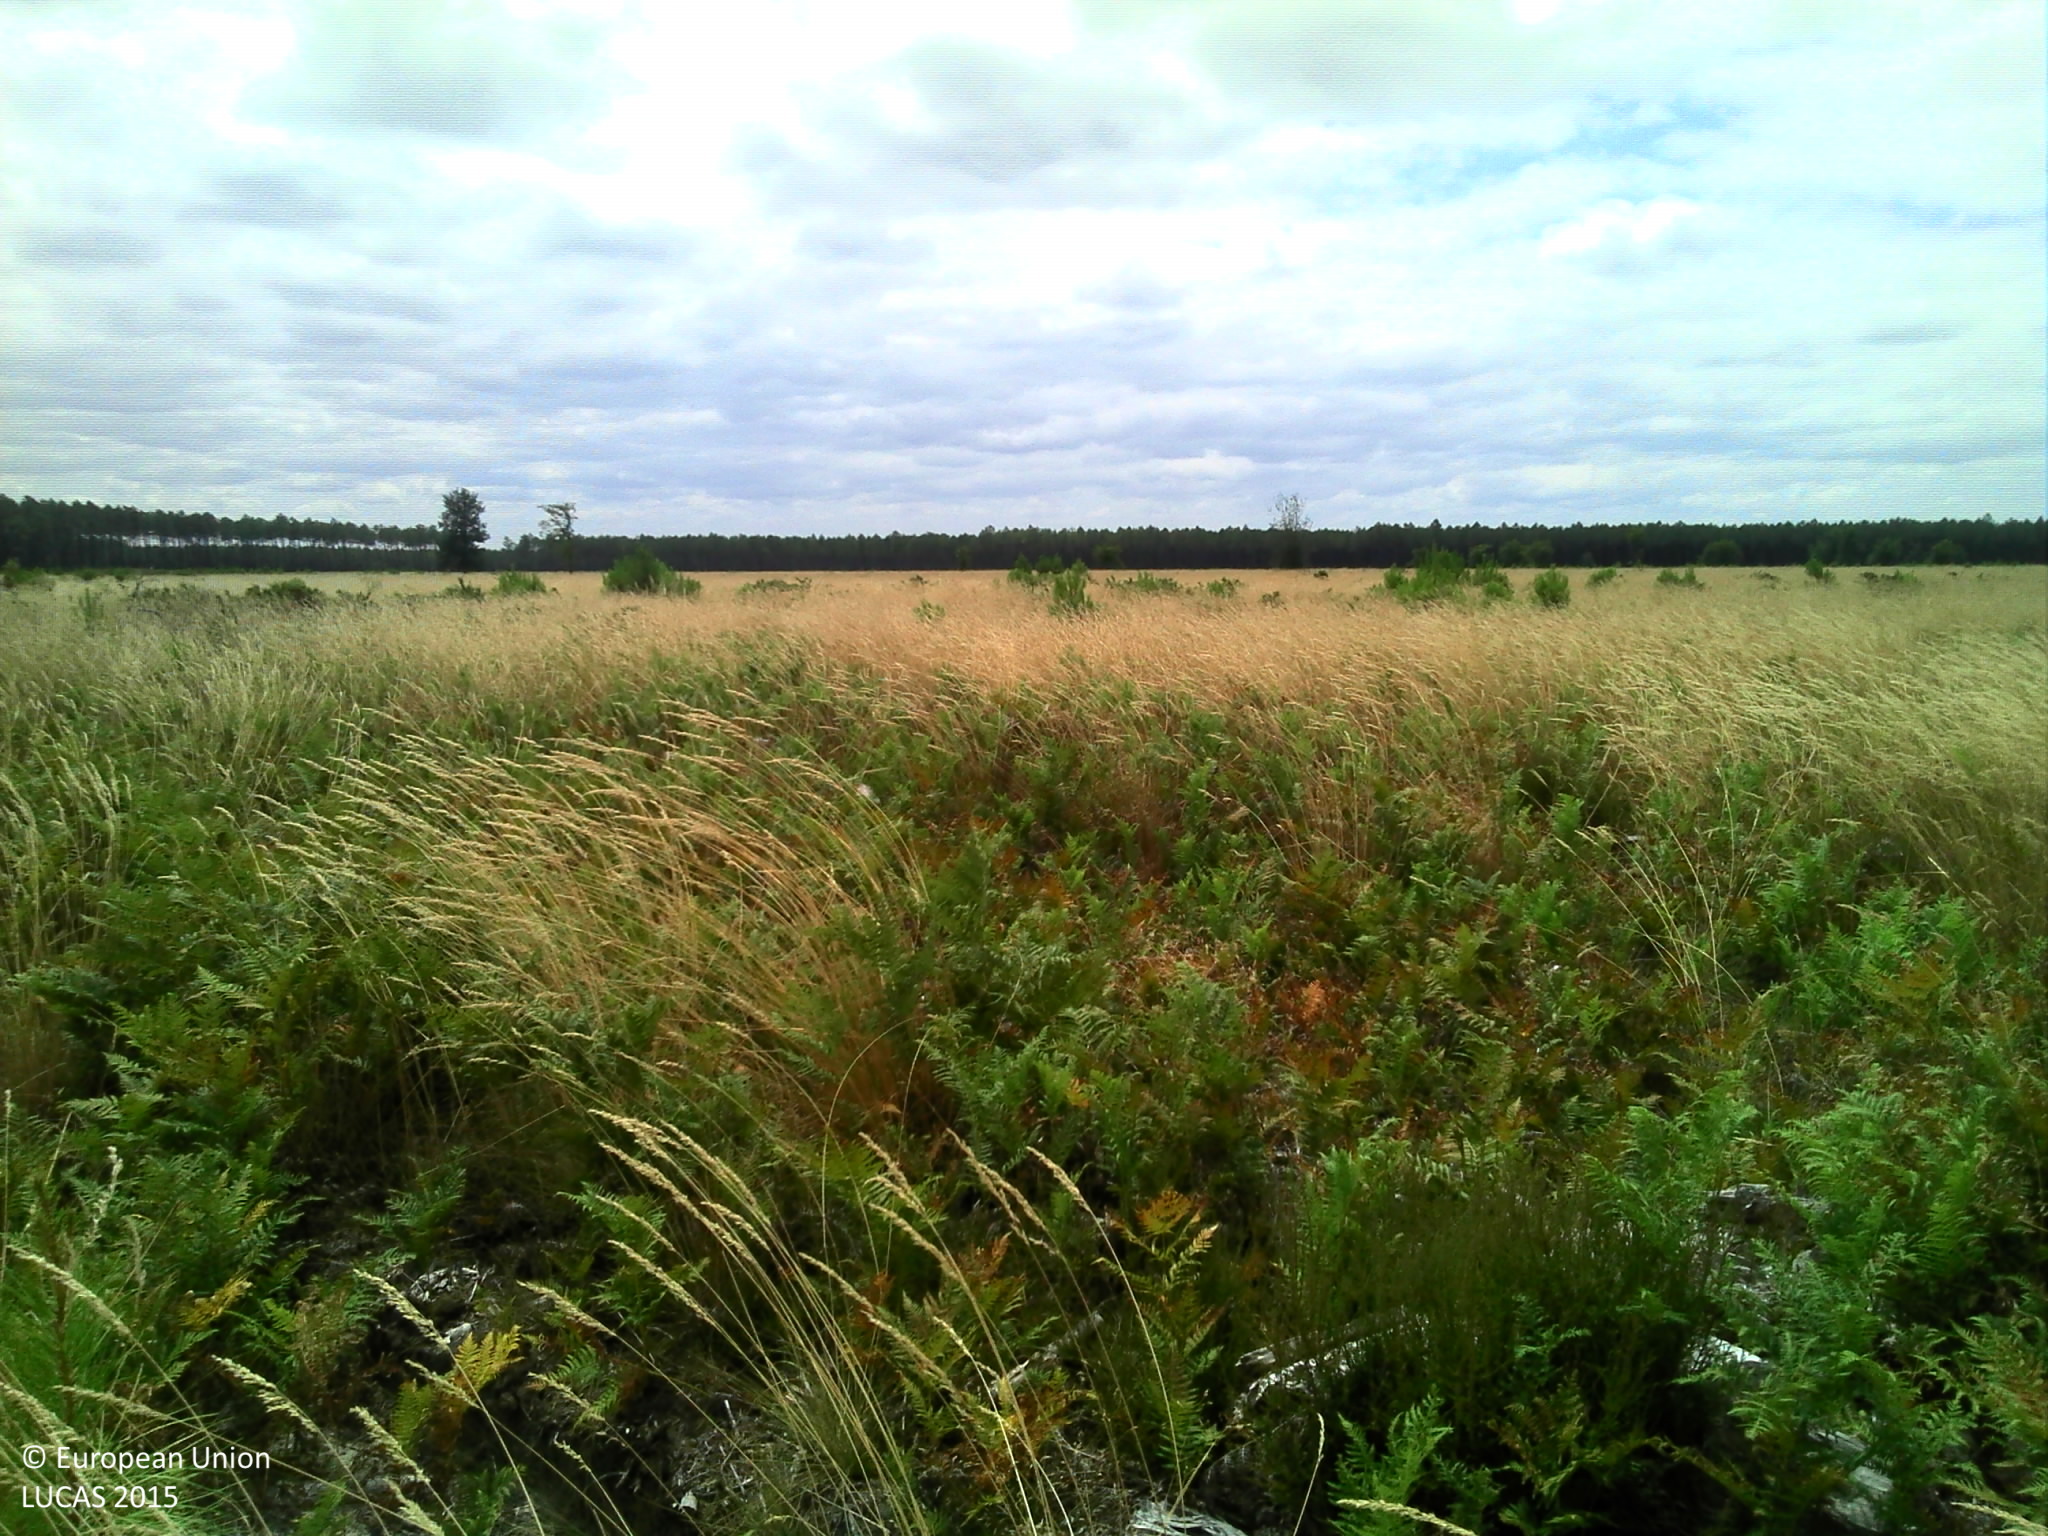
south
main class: Grassland
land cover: Grassland with sparse tree/shrub cover
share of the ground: > 75 %
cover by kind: herbaceous plants 85 %, broadleaved forest trees 5 %, shrubs 5 %, unconsolidated bare surface 5 %
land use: Forestry
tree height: < 5 m
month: July
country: FR
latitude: 43.9581
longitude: -1.2226
